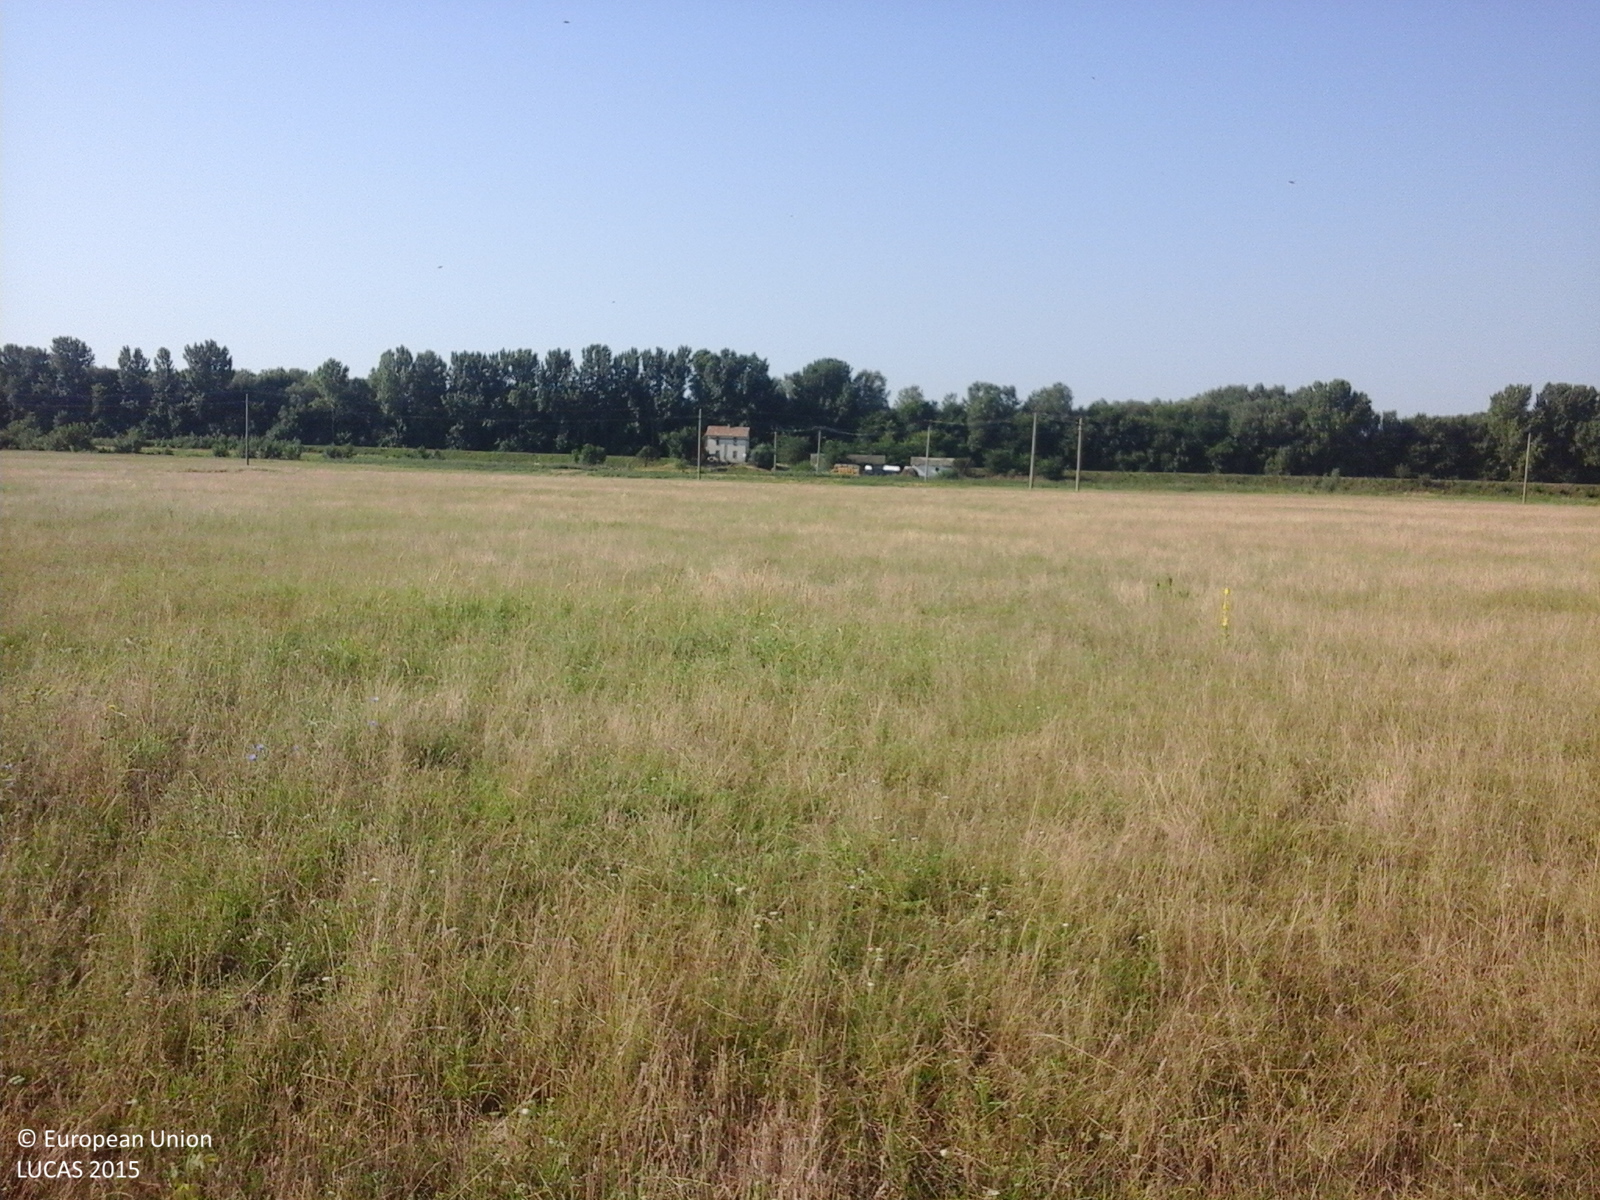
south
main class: Grassland
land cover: Grassland without tree/shrub cover
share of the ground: > 75 %
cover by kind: herbaceous plants 100 %
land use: Agriculture (excluding fallow land and kitchen gardens)
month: July
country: RO
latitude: 44.1499
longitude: 26.8877
